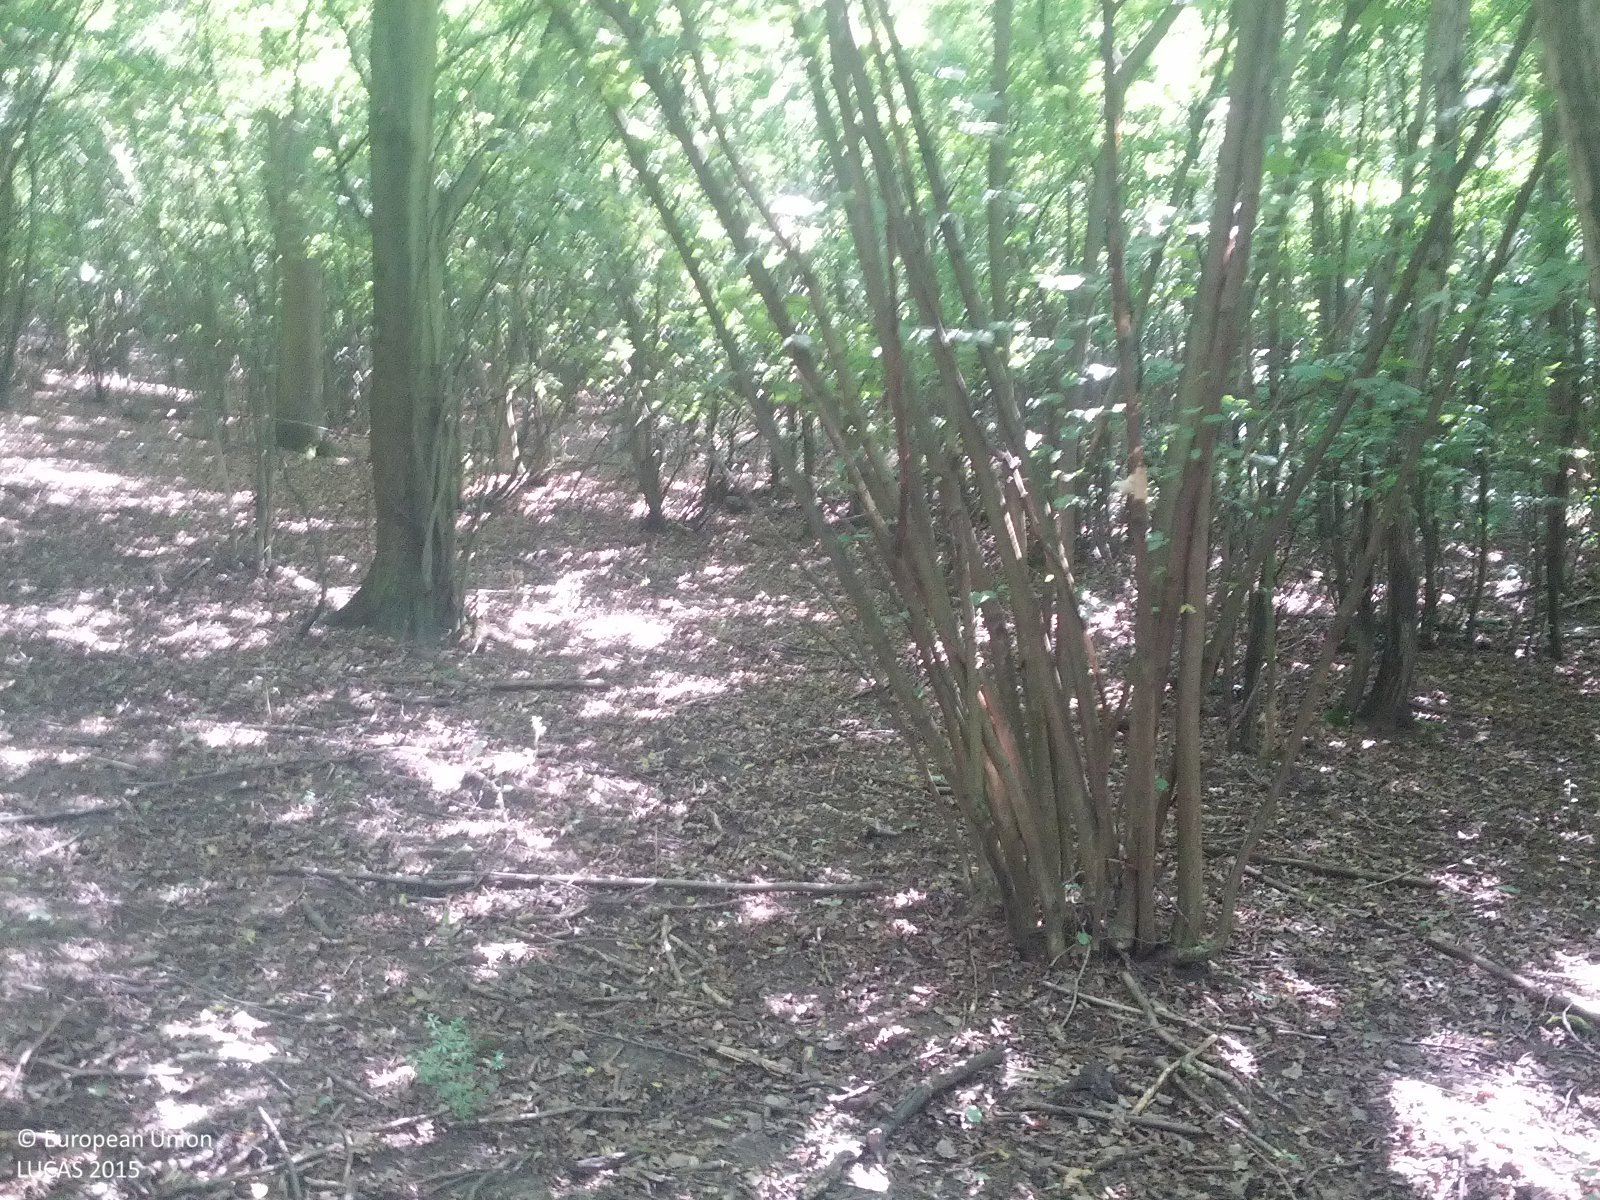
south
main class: Woodland
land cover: Broadleaved woodland
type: beech forest
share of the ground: > 75 %
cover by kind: broadleaved forest trees 90 %, herbaceous plants 5 %, unconsolidated bare surface 5 %
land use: Forestry
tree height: > 5 m
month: July
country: AT
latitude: 48.5554
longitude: 16.4958
